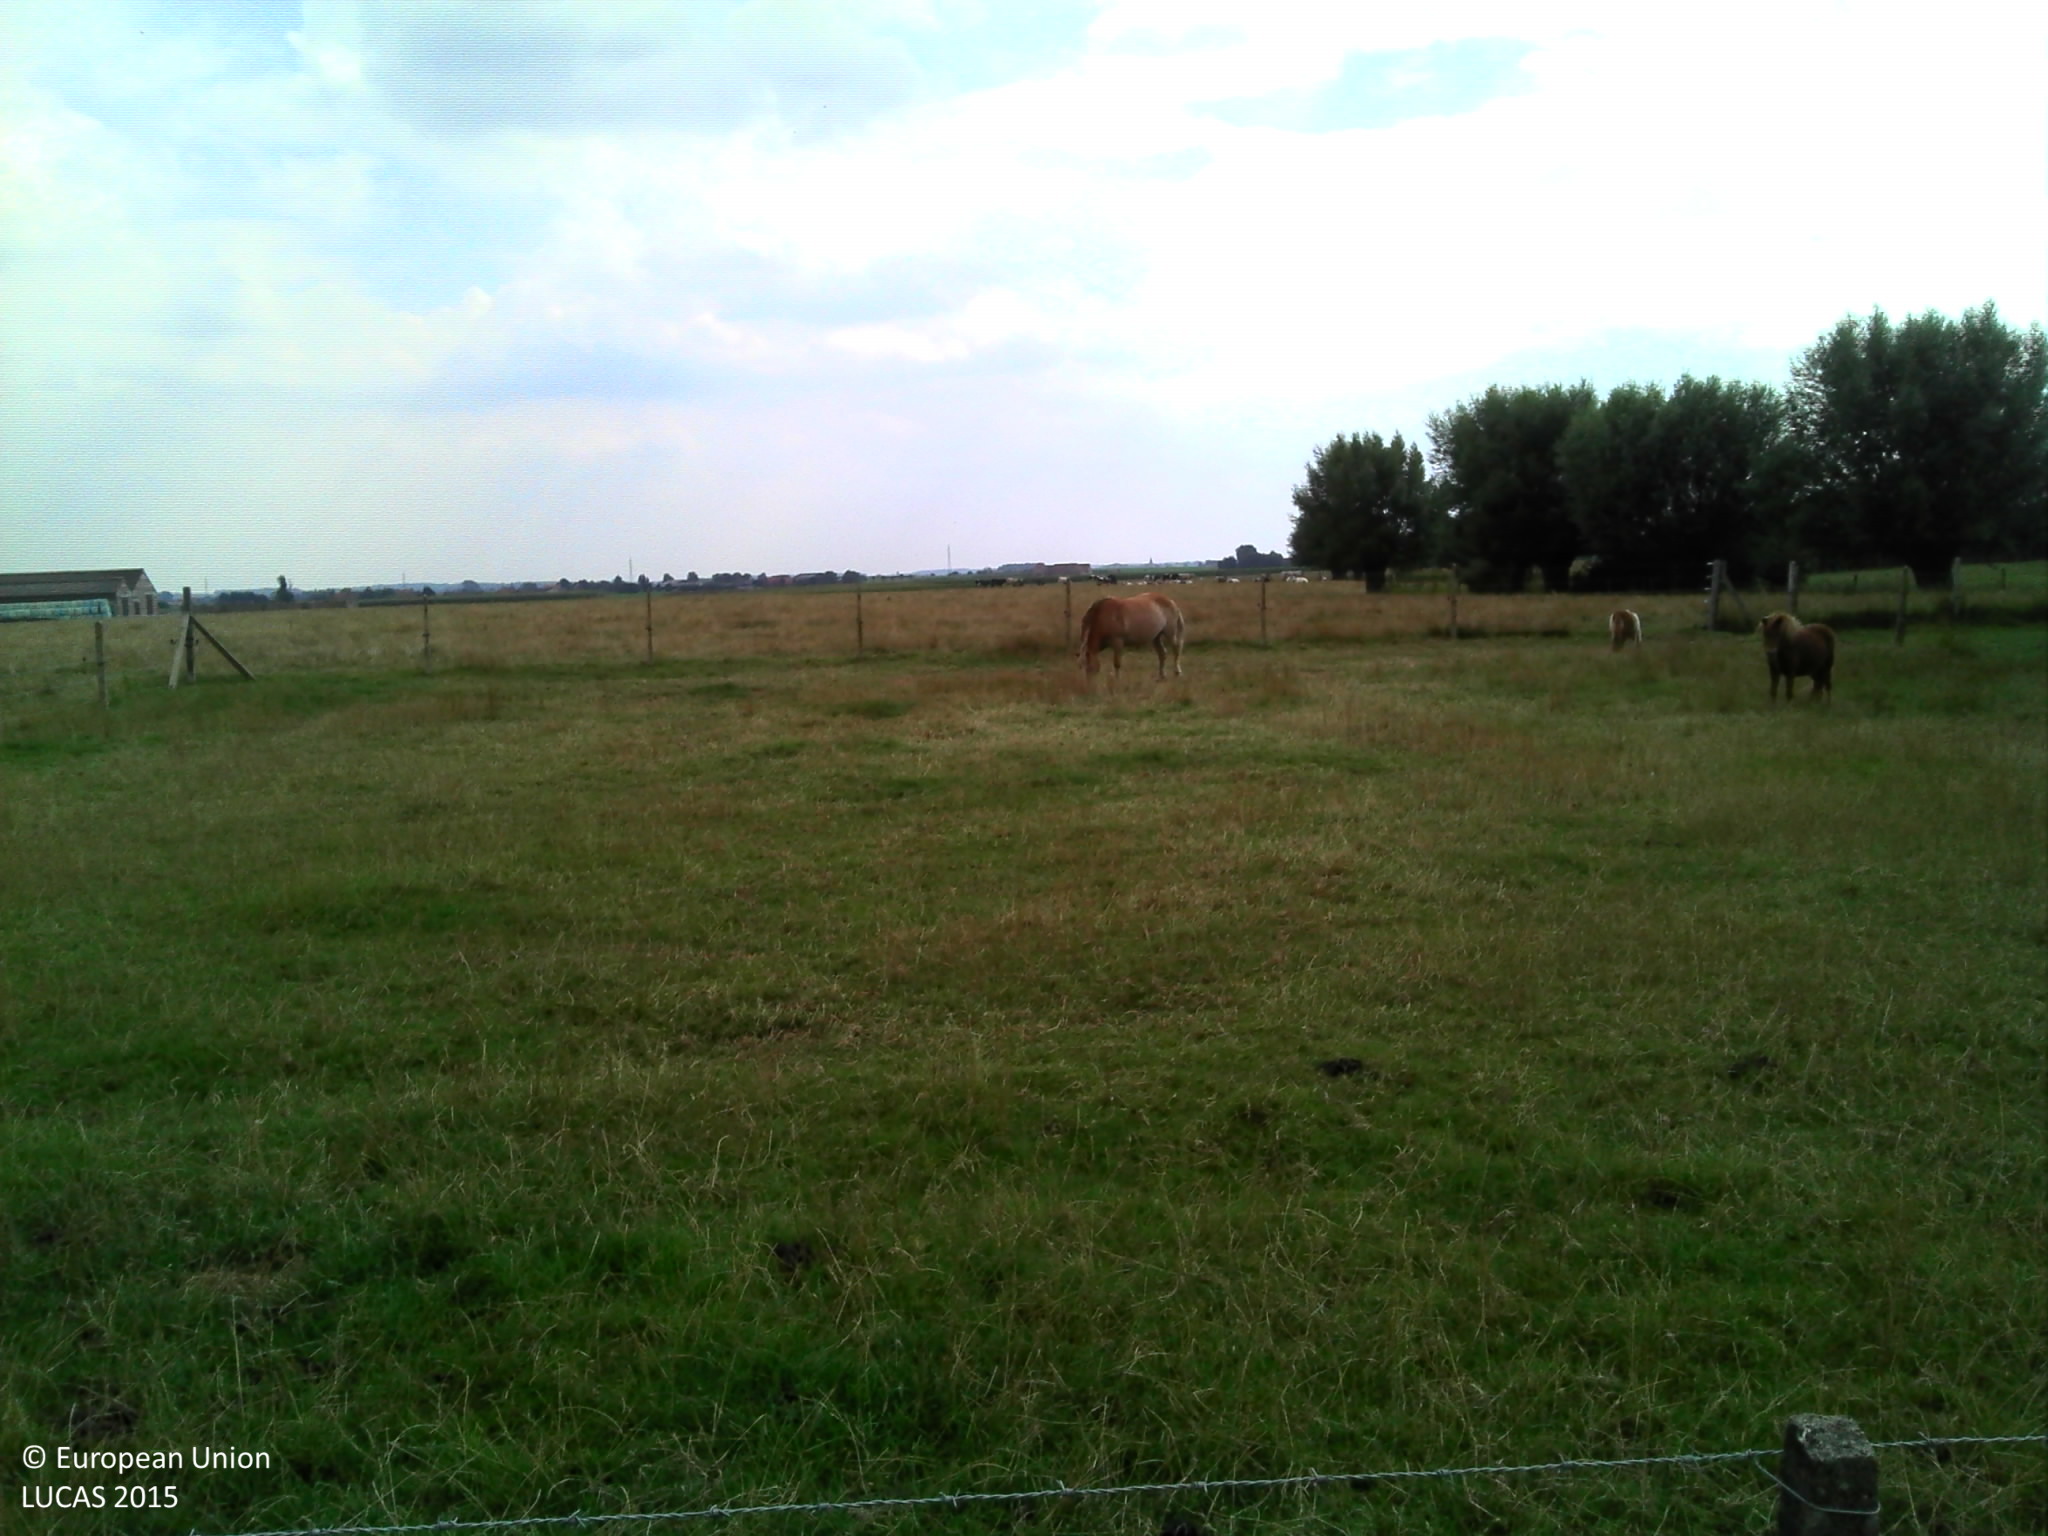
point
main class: Grassland
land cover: Grassland without tree/shrub cover
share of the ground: > 75 %
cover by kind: herbaceous plants 100 %
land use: Agriculture (excluding fallow land and kitchen gardens)
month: August
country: BE
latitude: 50.9011
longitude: 2.8939
